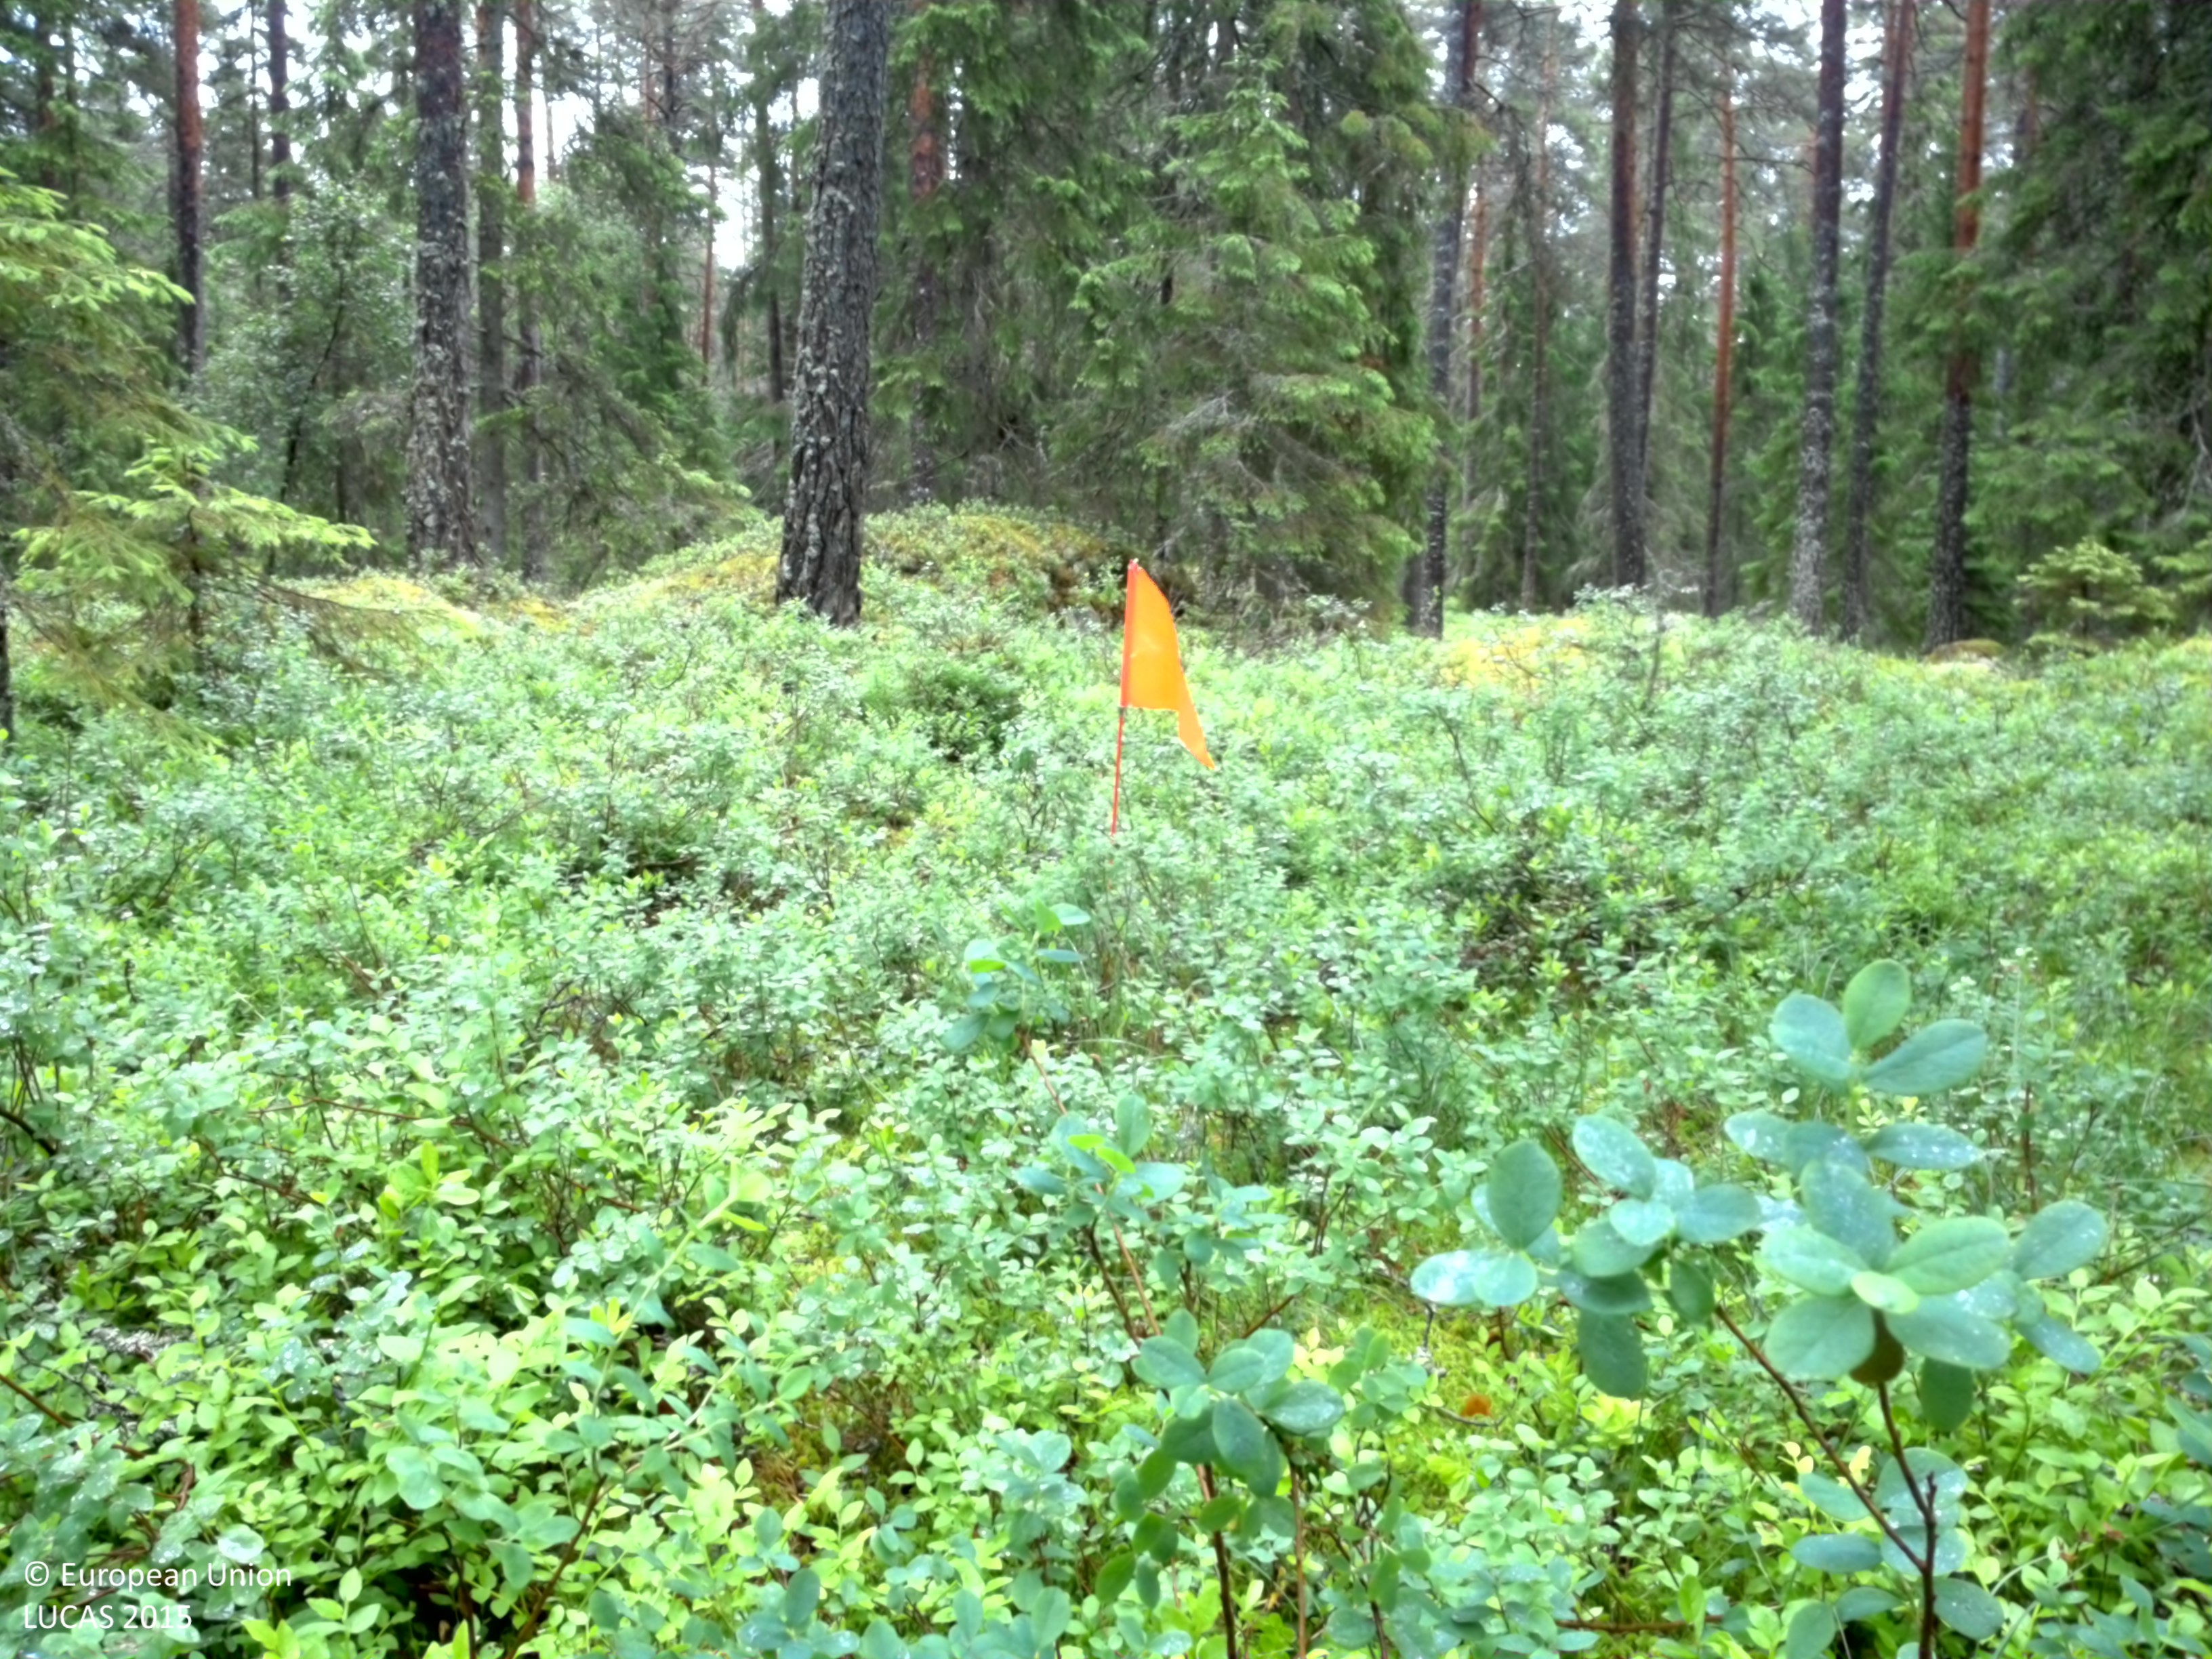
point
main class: Woodland
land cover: Pine dominated coniferous woodland
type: boreal forest
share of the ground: > 75 %
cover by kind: coniferous forest trees 80 %, broadleaved forest trees 10 %, lichens and mosses 10 %
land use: Amenities, museums, leisure
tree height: > 5 m
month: June
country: SE
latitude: 59.8366
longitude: 17.1476
